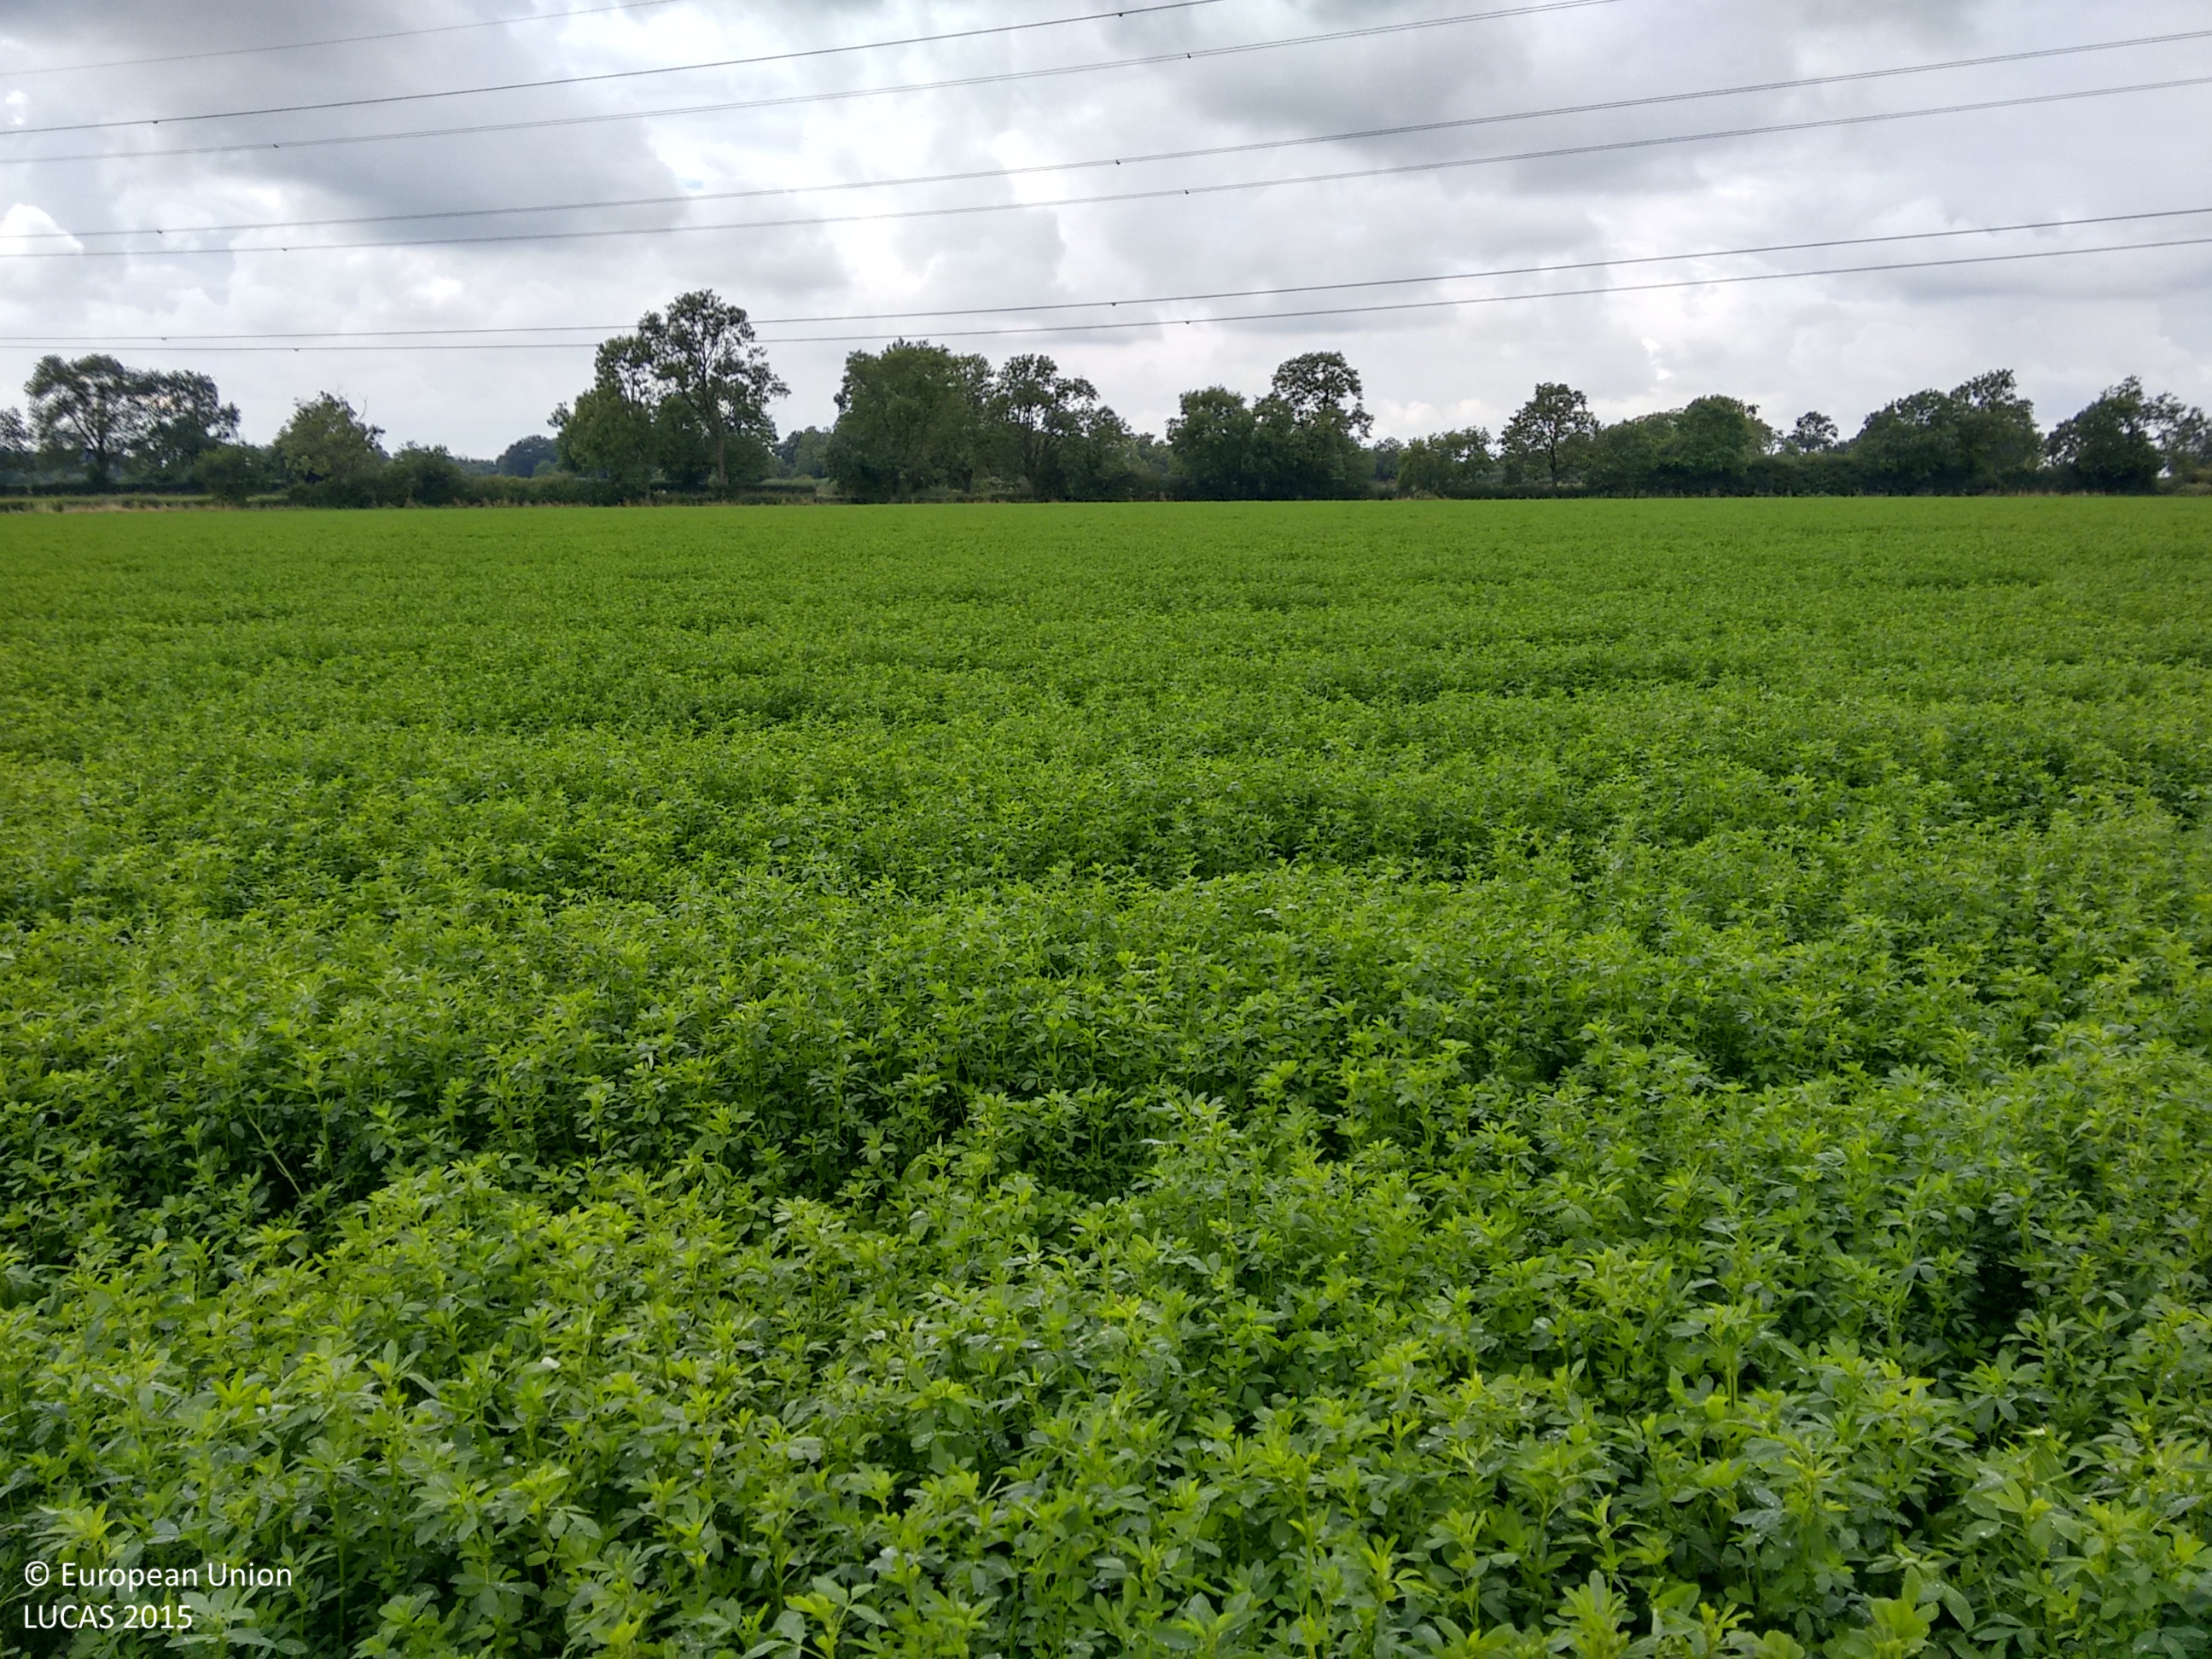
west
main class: Cropland
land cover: Lucerne
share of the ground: > 75 %
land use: Agriculture (excluding fallow land and kitchen gardens)
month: September
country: GB
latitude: 52.4817
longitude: -1.1933
